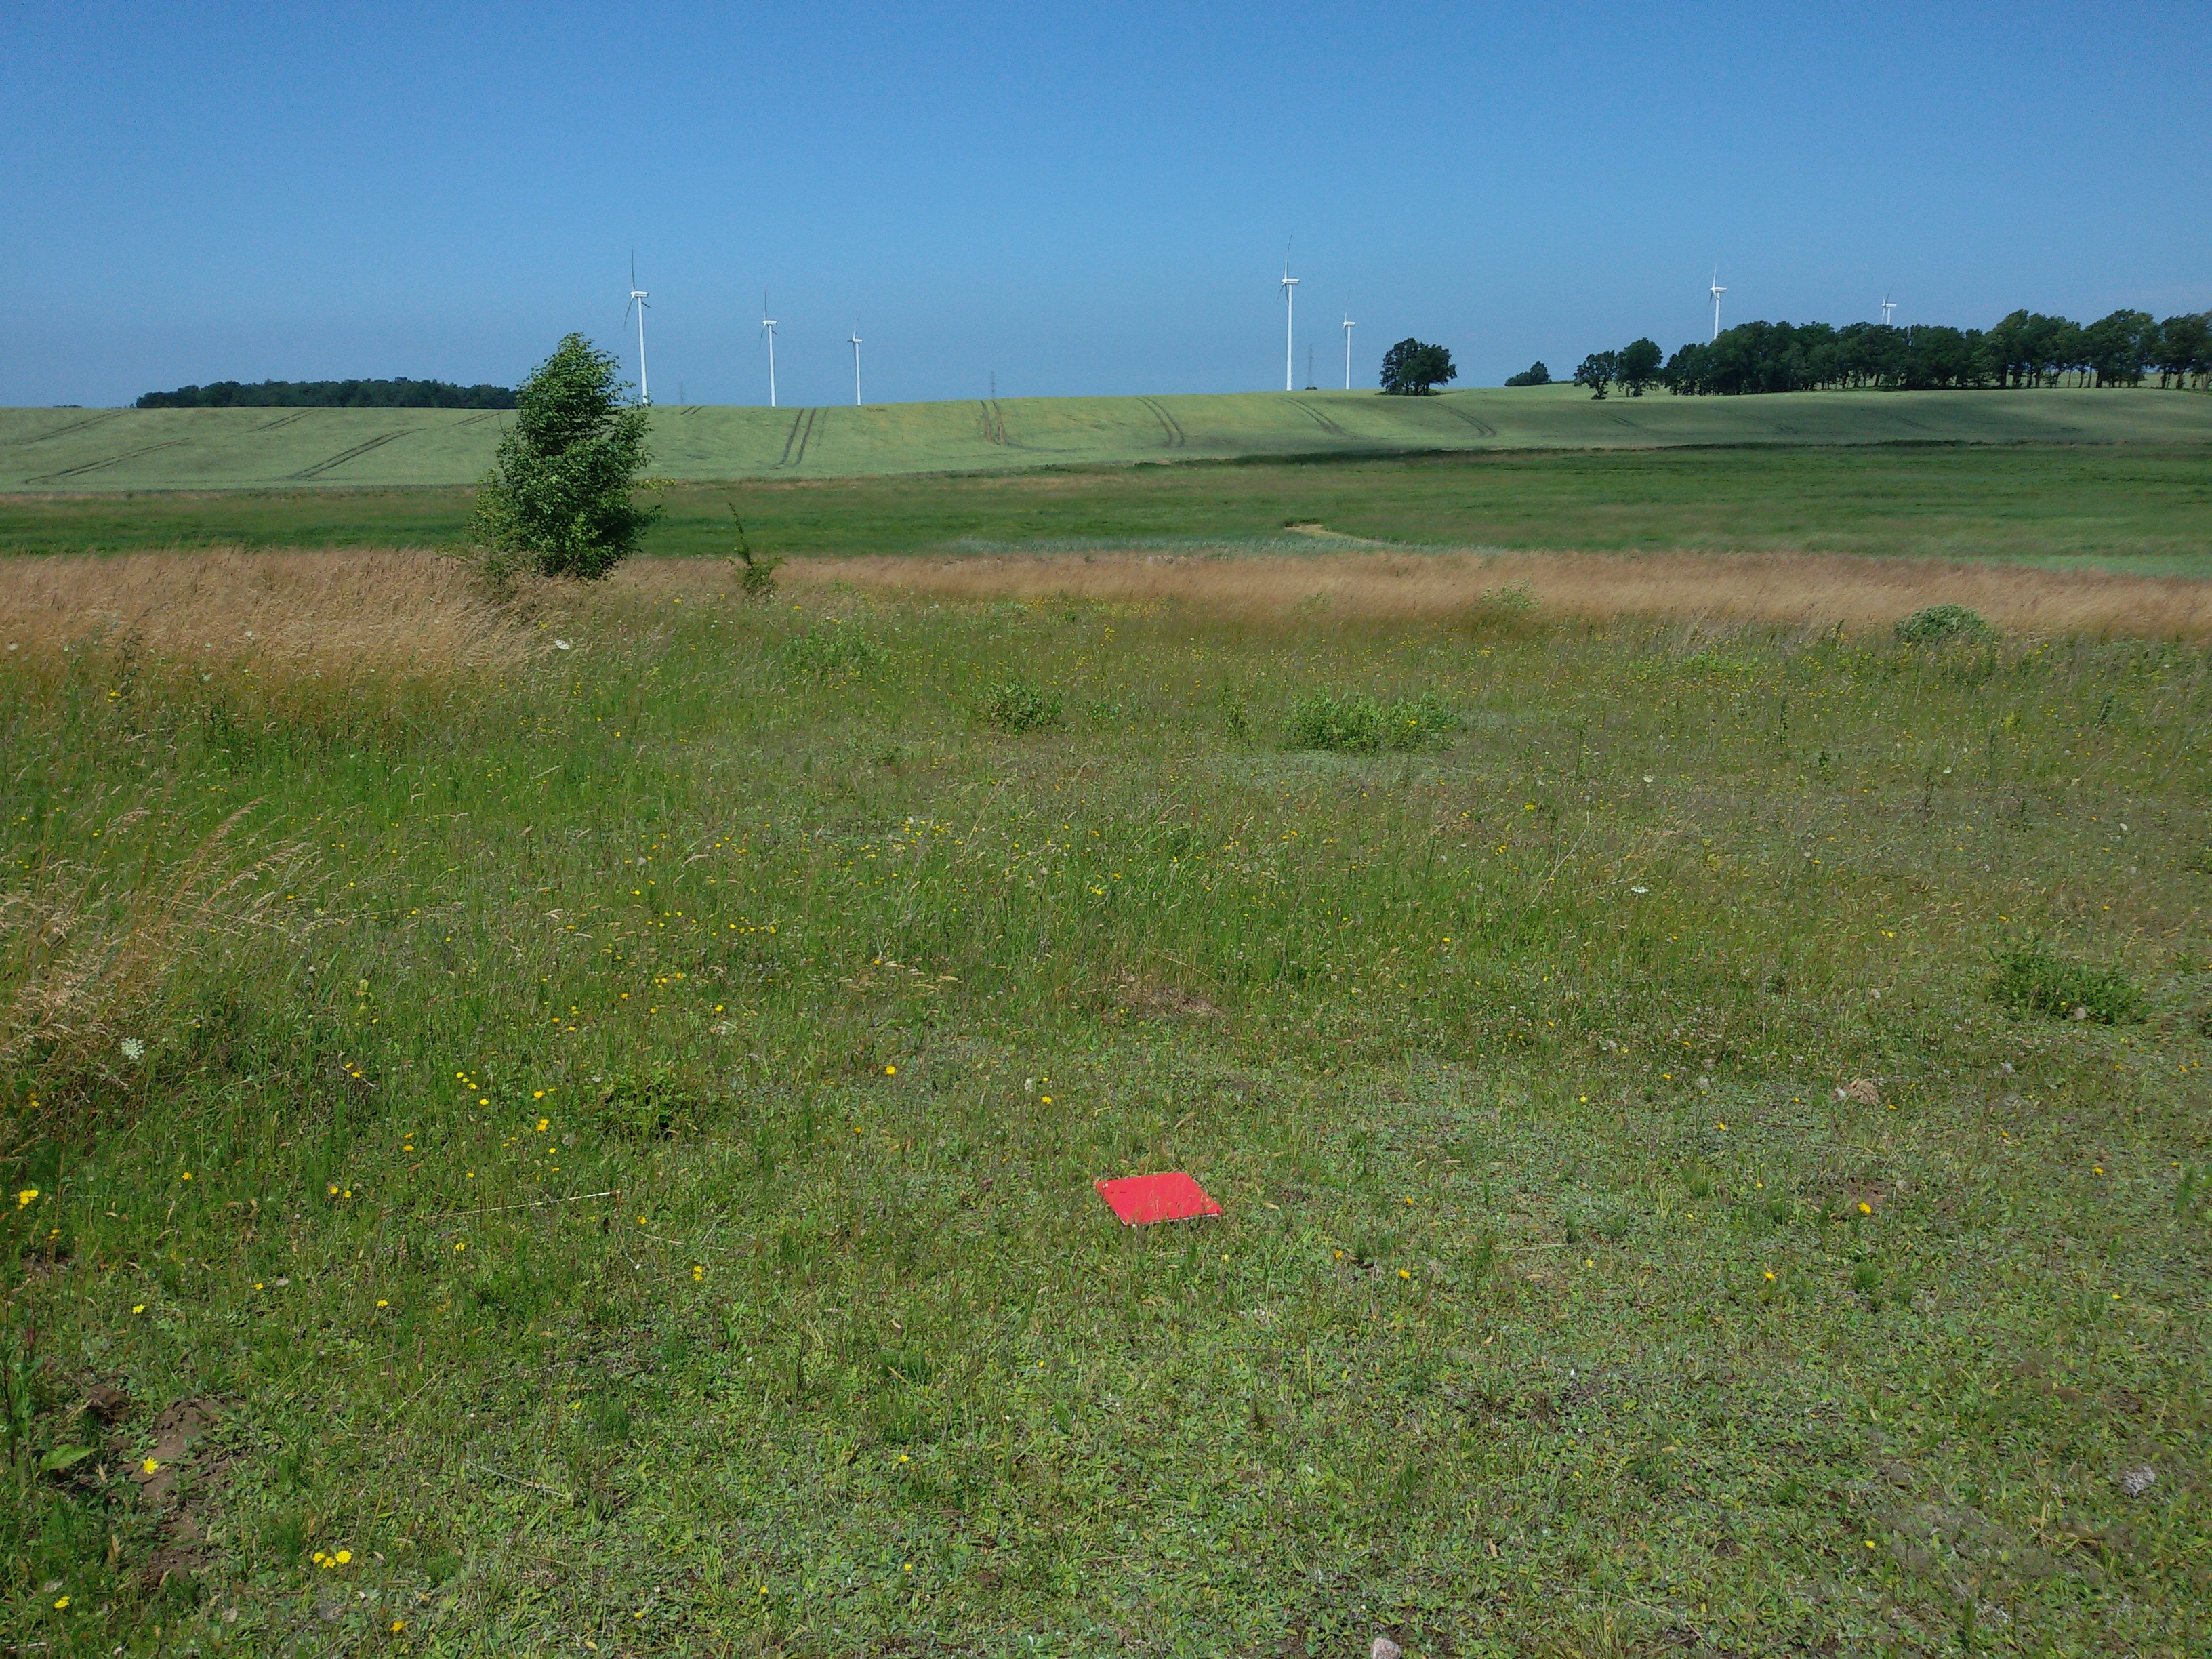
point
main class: Grassland
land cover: Spontaneously vegetated surfaces
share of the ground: > 75 %
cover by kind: herbaceous plants 100 %
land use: Fallow land
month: July
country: PL
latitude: 54.1787
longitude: 15.8719
